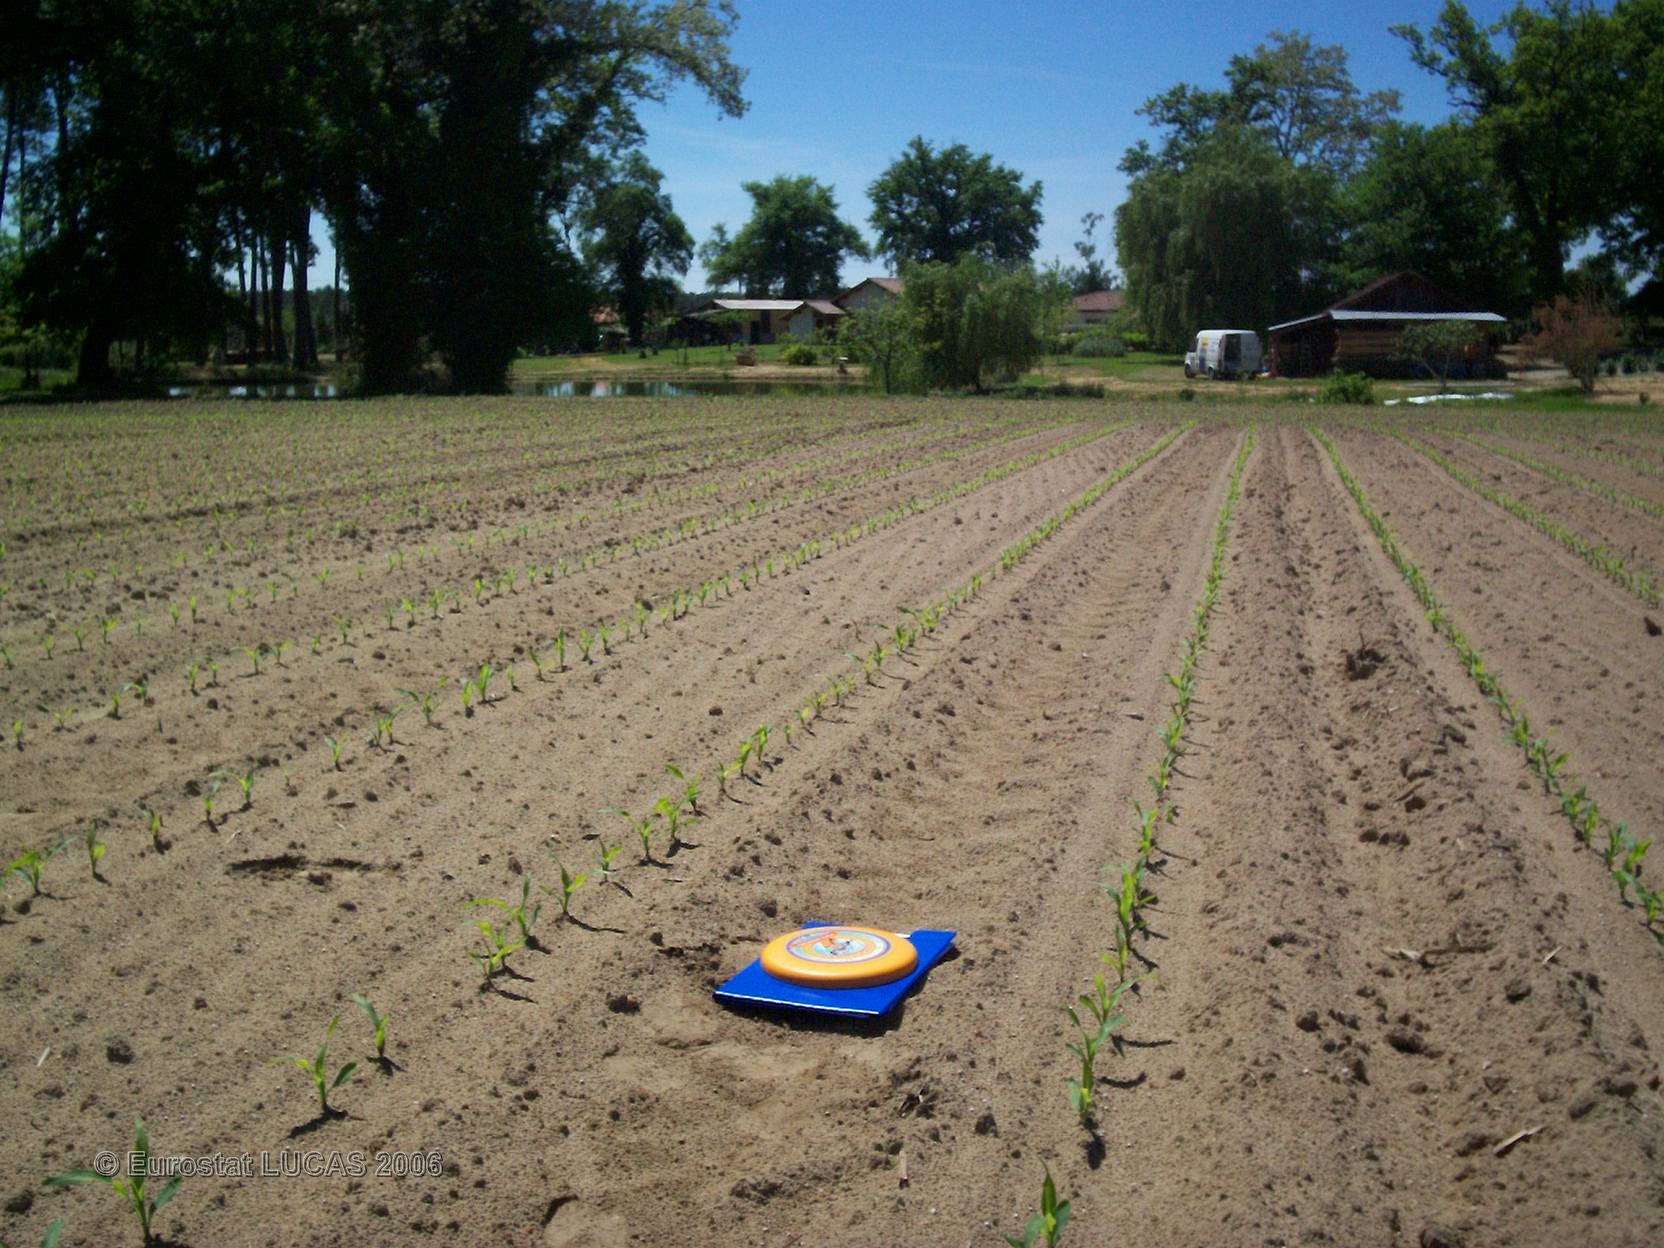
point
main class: Cropland
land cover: Maize
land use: Agriculture (excluding fallow land and kitchen gardens)
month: May
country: FR
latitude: 43.9905
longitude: -0.7505
